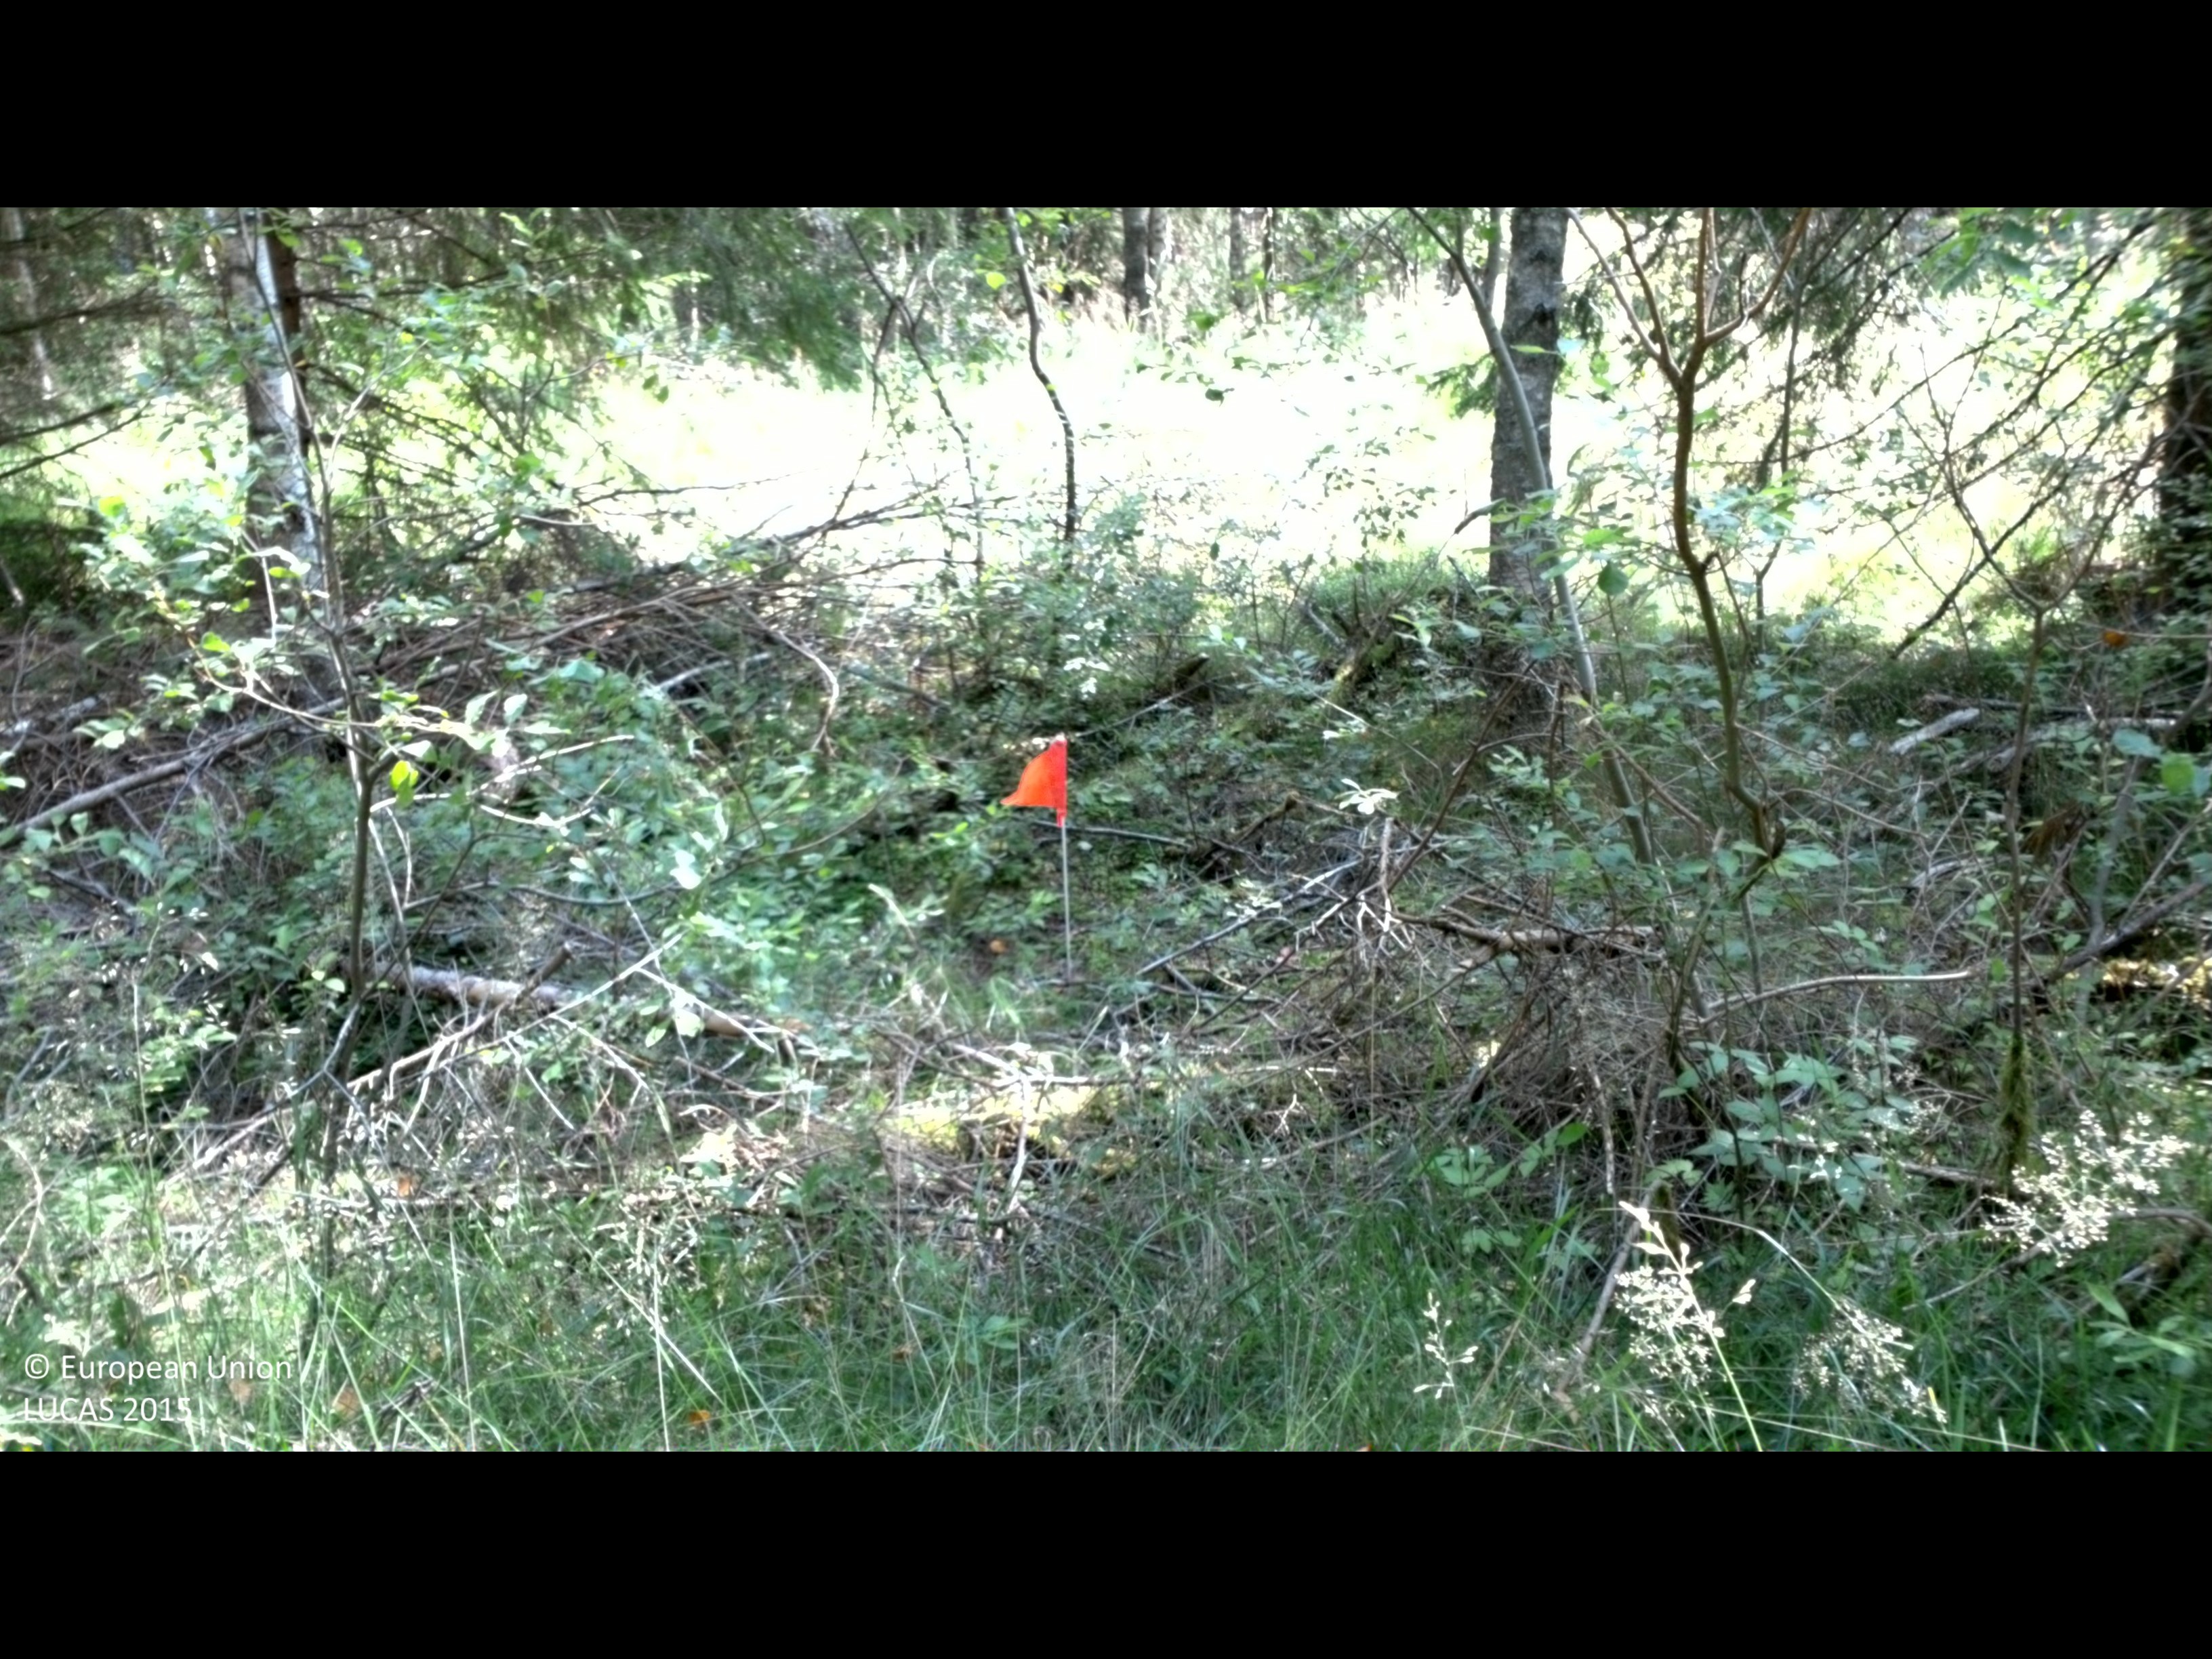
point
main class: Woodland
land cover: Spruce dominated mixed woodland
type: boreal forest
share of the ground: 50 - 75 %
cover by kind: coniferous forest trees 45 %, herbaceous plants 25 %, broadleaved forest trees 15 %, shrubs 15 %
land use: Forestry
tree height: > 5 m
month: August
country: SE
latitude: 56.4052
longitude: 14.2593
